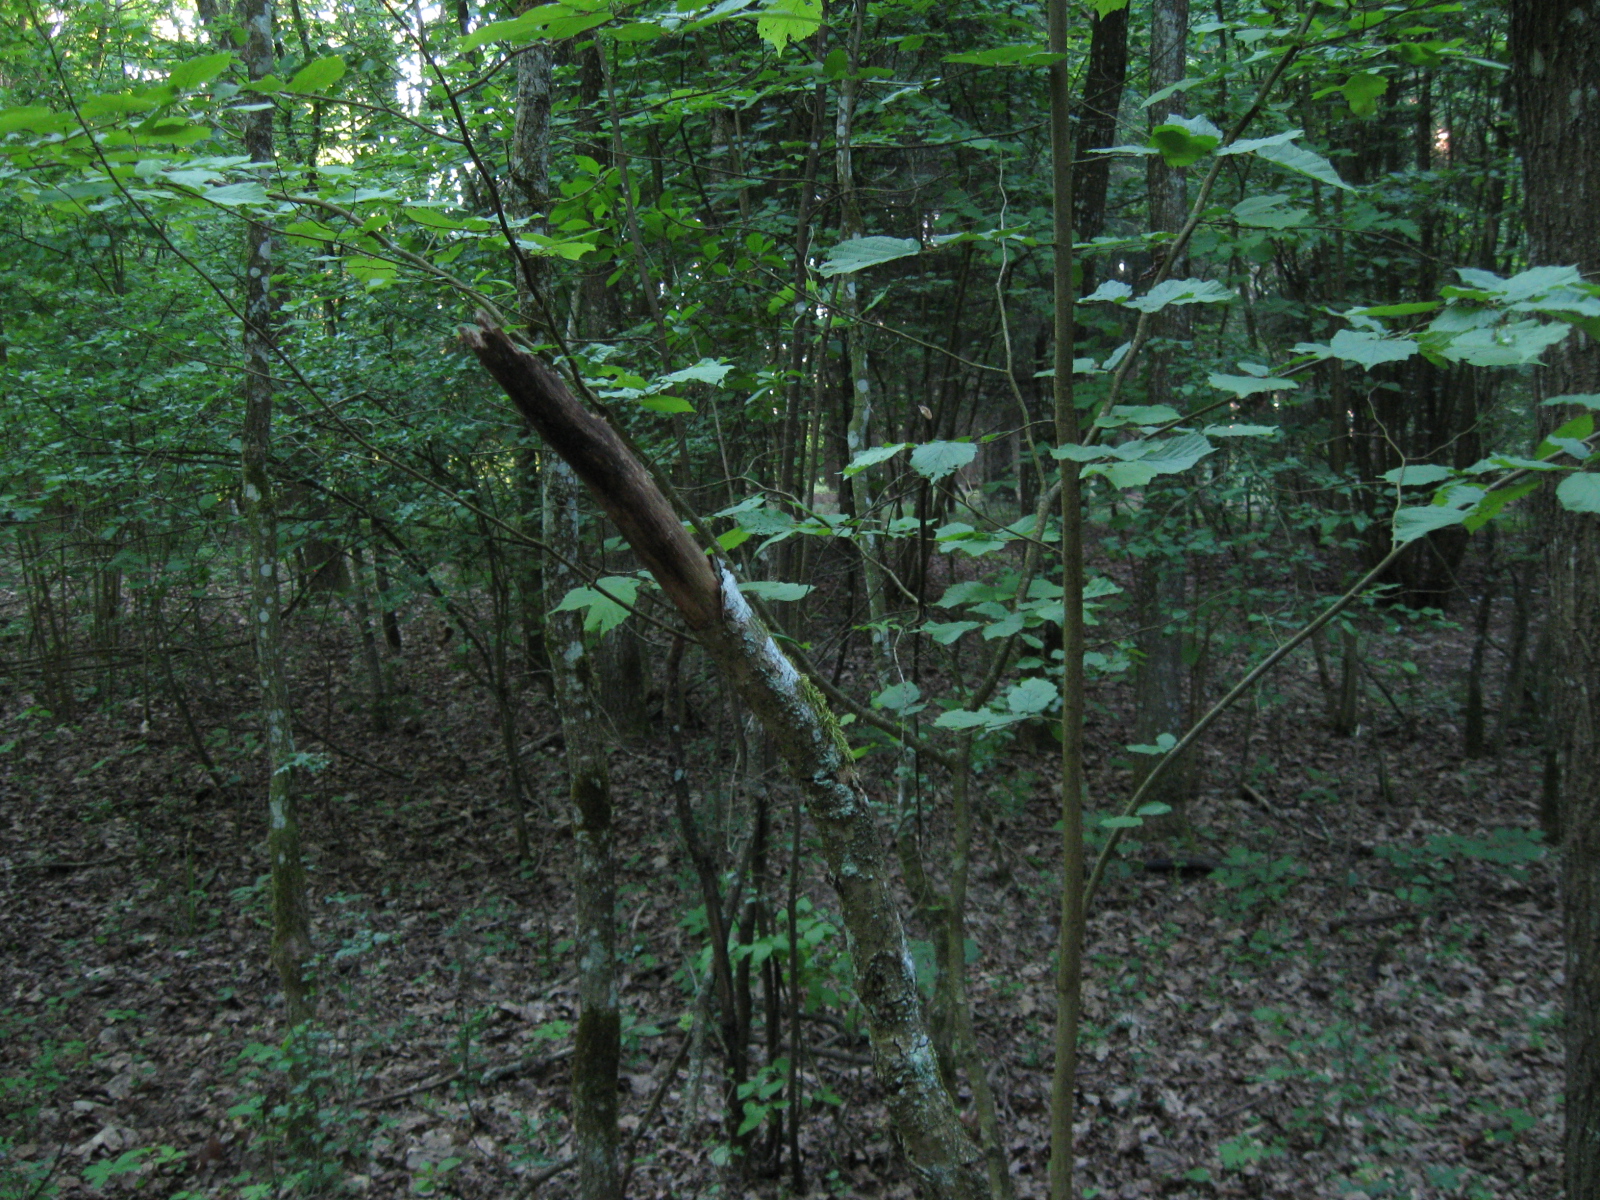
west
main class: Woodland
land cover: Spruce dominated mixed woodland
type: hemiboreal forest and nemoral coniferous forest and mixed broadleaved-coniferous forest
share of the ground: > 75 %
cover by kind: broadleaved forest trees 60 %, coniferous forest trees 40 %
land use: Forestry
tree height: > 5 m
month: June
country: LT
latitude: 54.4548
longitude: 23.9263
